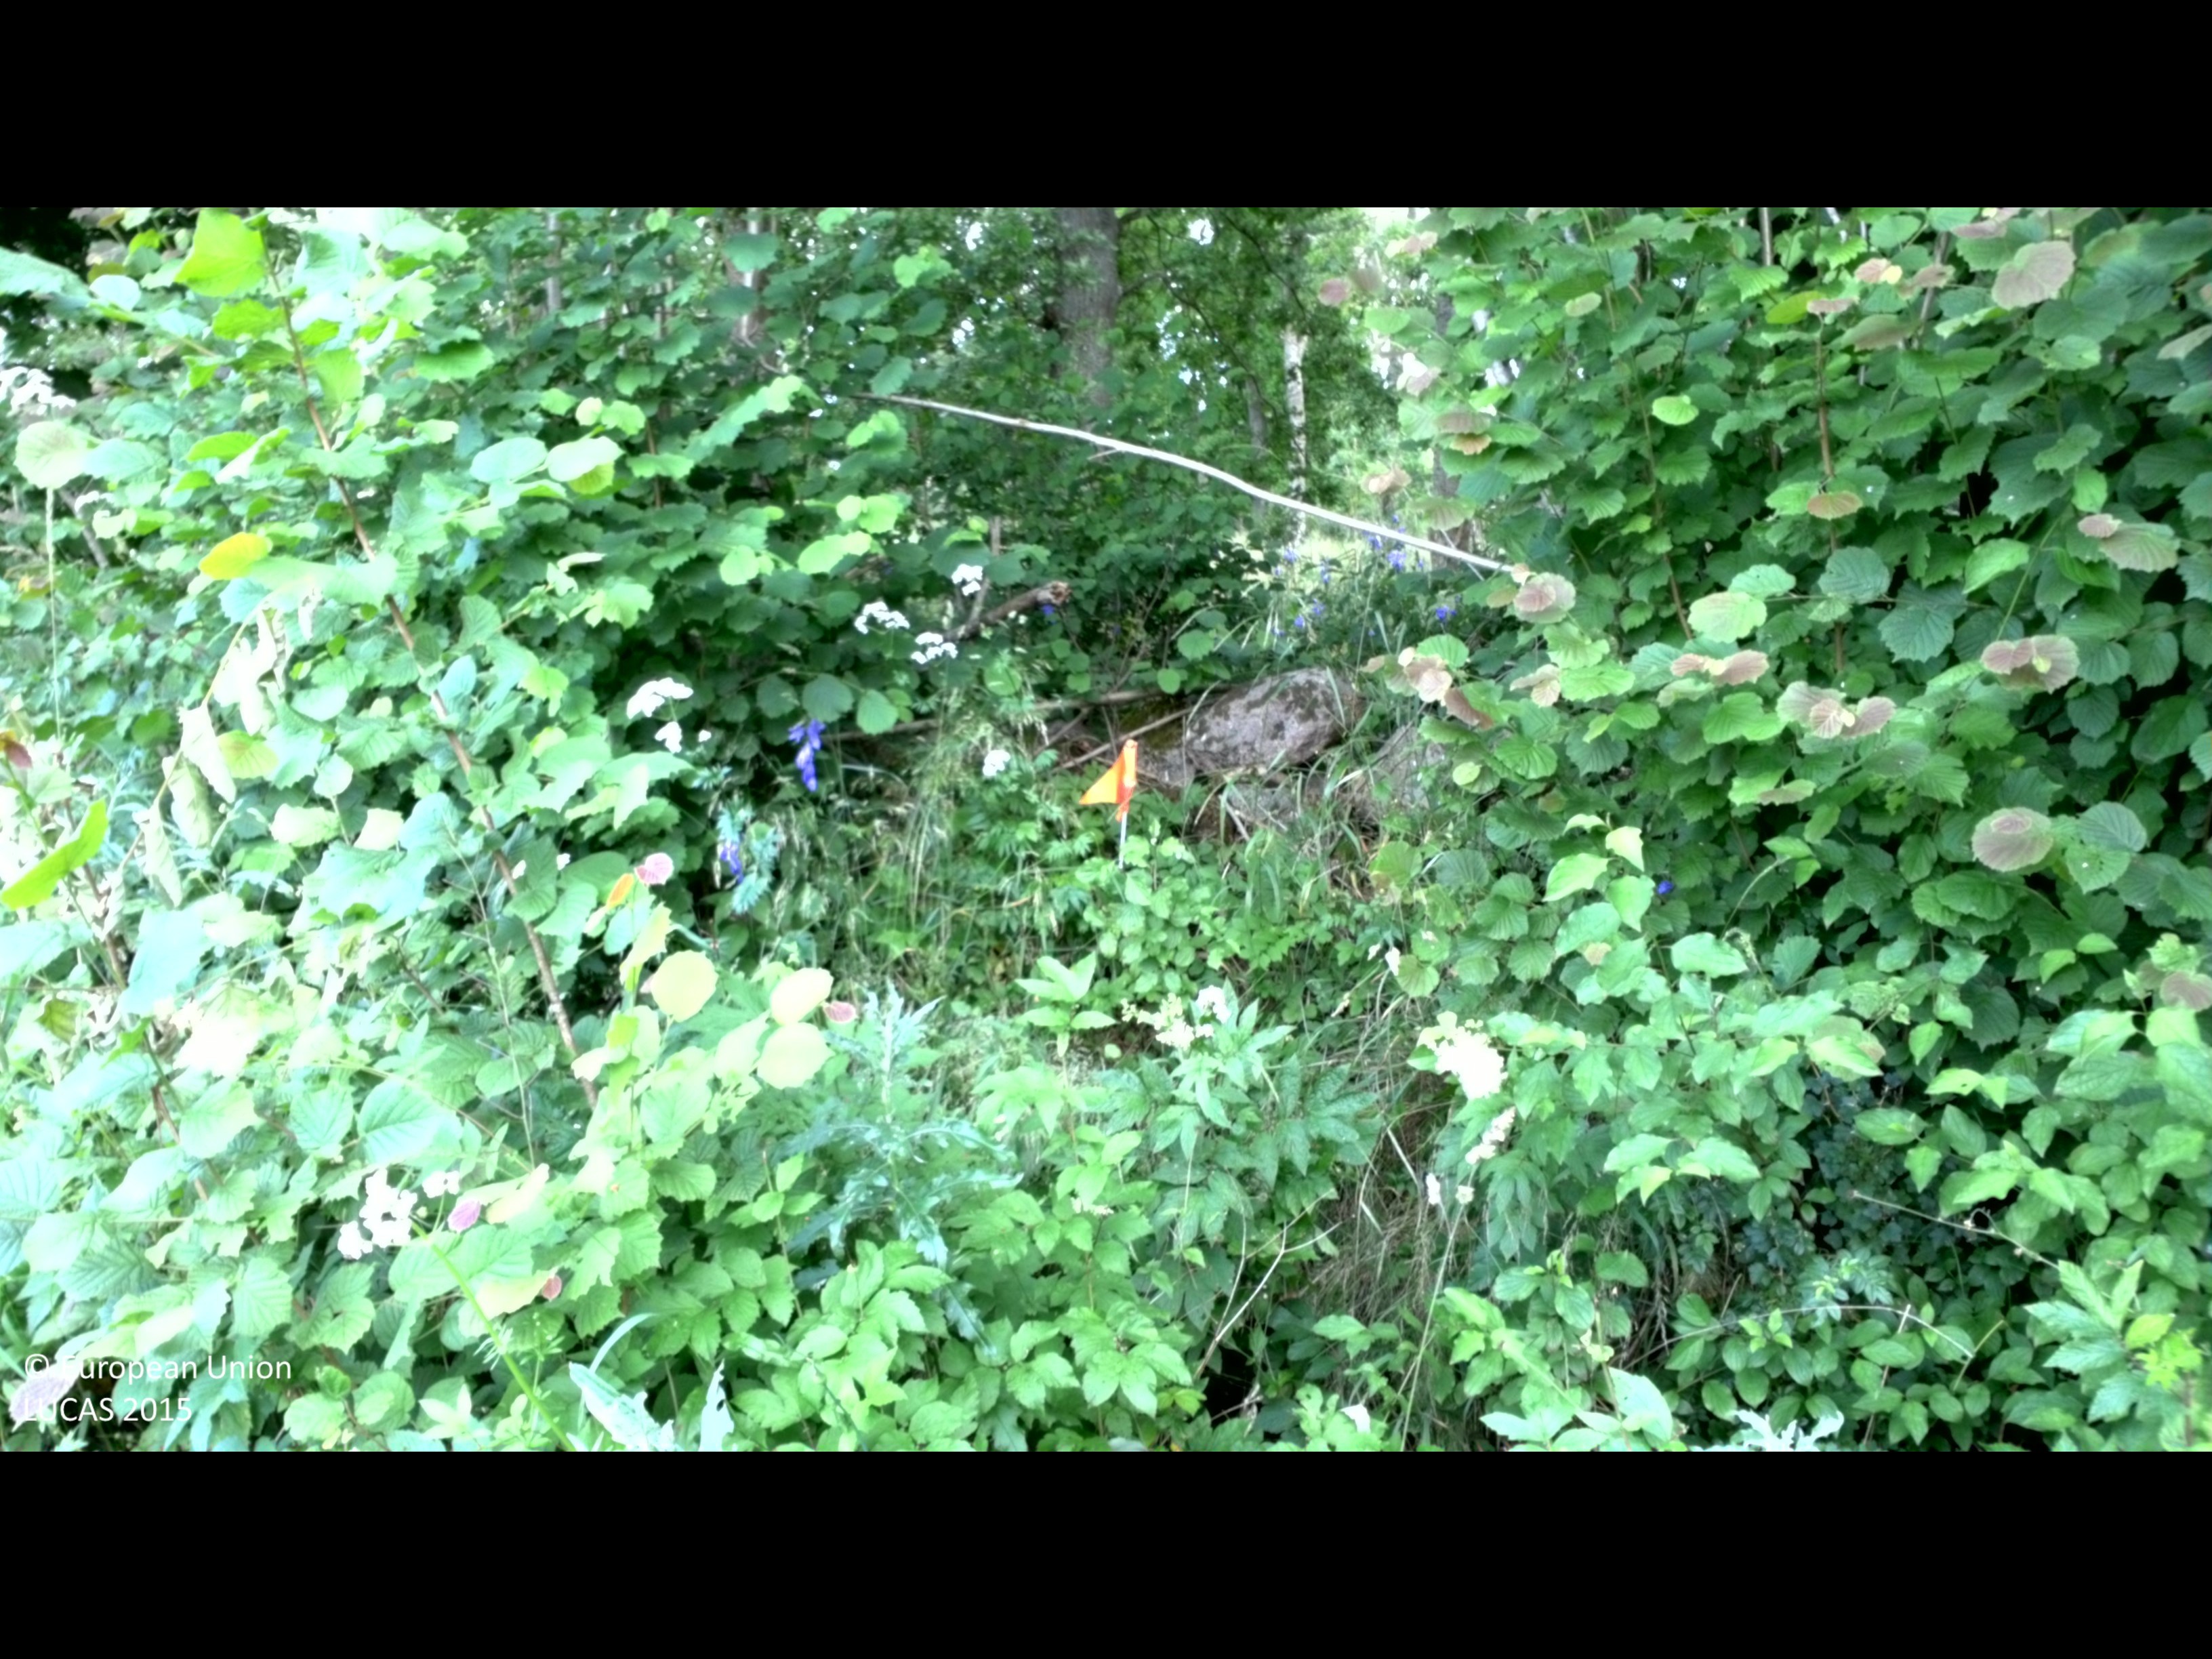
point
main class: Woodland
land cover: Broadleaved woodland
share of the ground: 25 - 50 %
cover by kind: broadleaved forest trees 50 %, shrubs 40 %, herbaceous plants 10 %
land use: Semi-natural and natural areas not in use
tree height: < 5 m
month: July
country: SE
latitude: 56.6653
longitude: 16.6427
